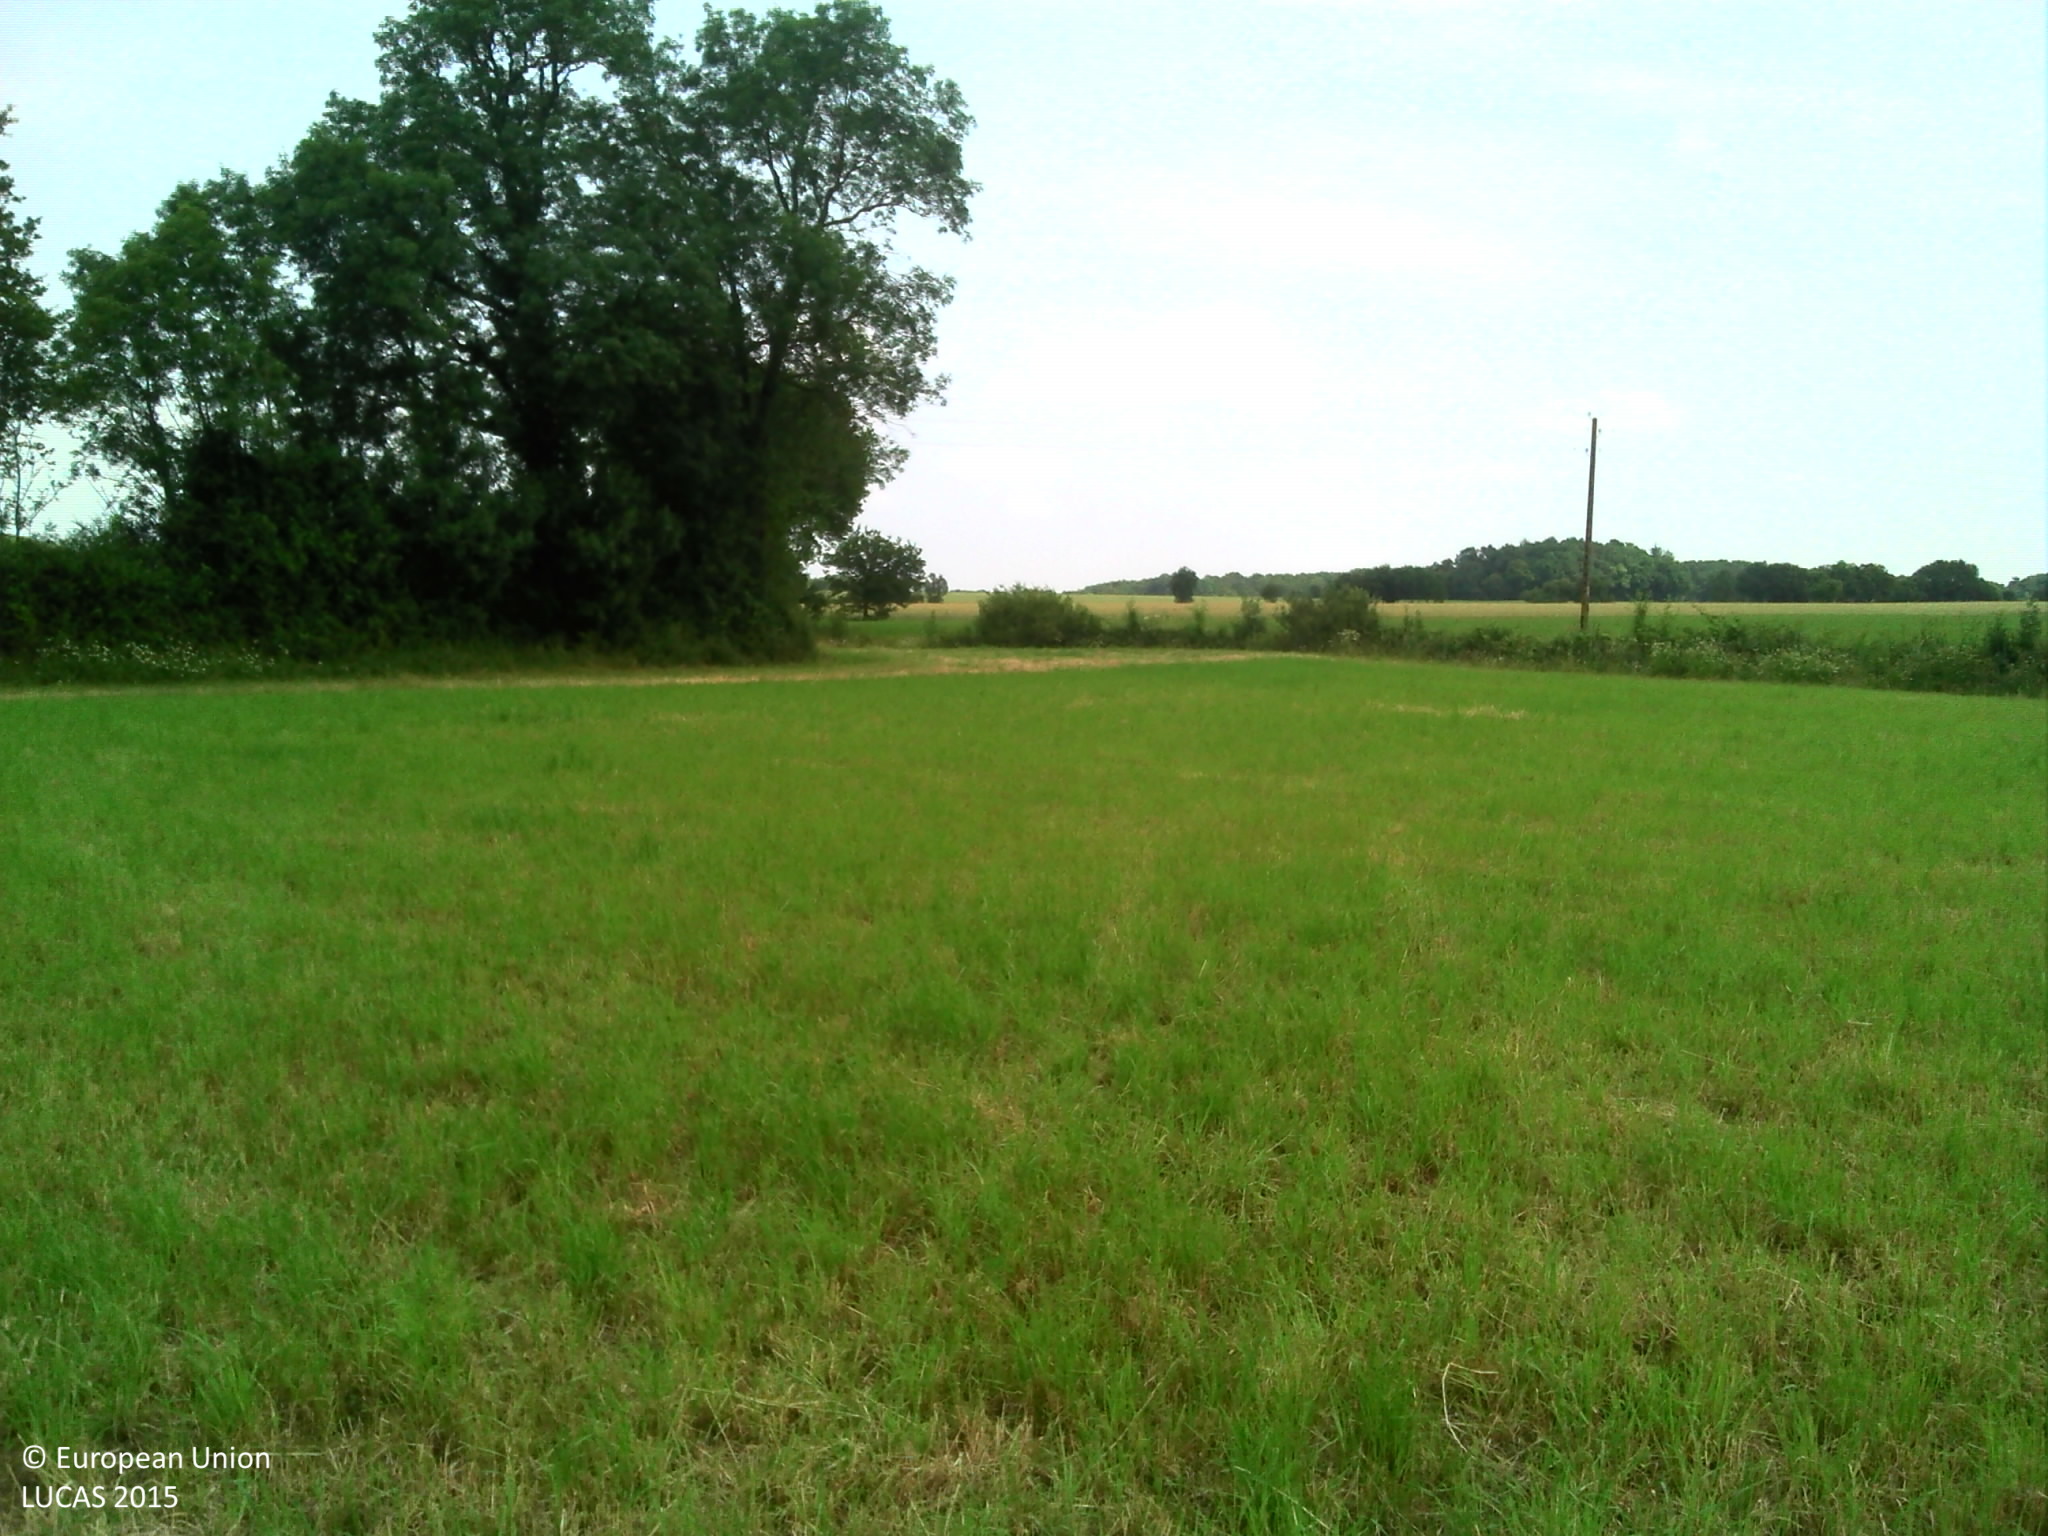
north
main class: Cropland
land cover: Temporary grasslands
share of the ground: > 75 %
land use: Agriculture (excluding fallow land and kitchen gardens)
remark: Harvested field
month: June
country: FR
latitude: 46.9243
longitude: -1.3718
